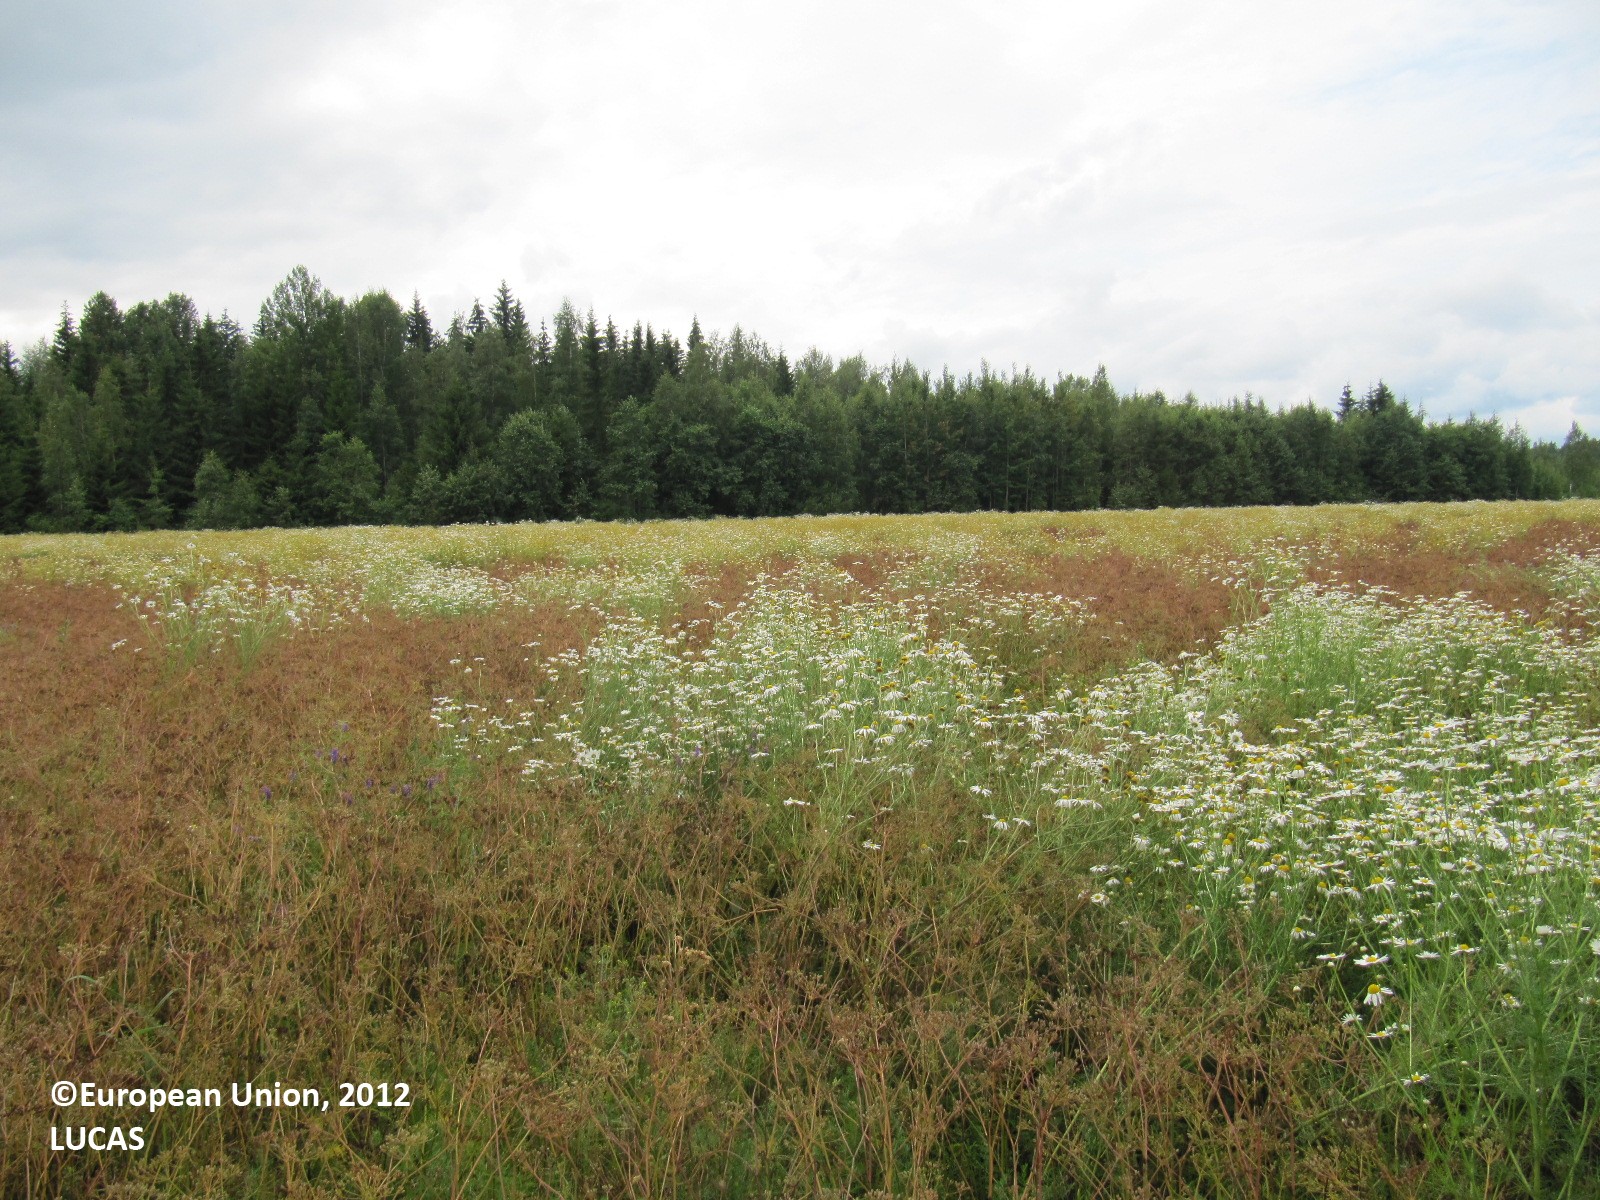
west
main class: Cropland
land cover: Other non-permanent industrial crops
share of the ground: > 75 %
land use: Agriculture (excluding fallow land and kitchen gardens)
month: July
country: FI
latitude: 60.7219
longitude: 23.2609
